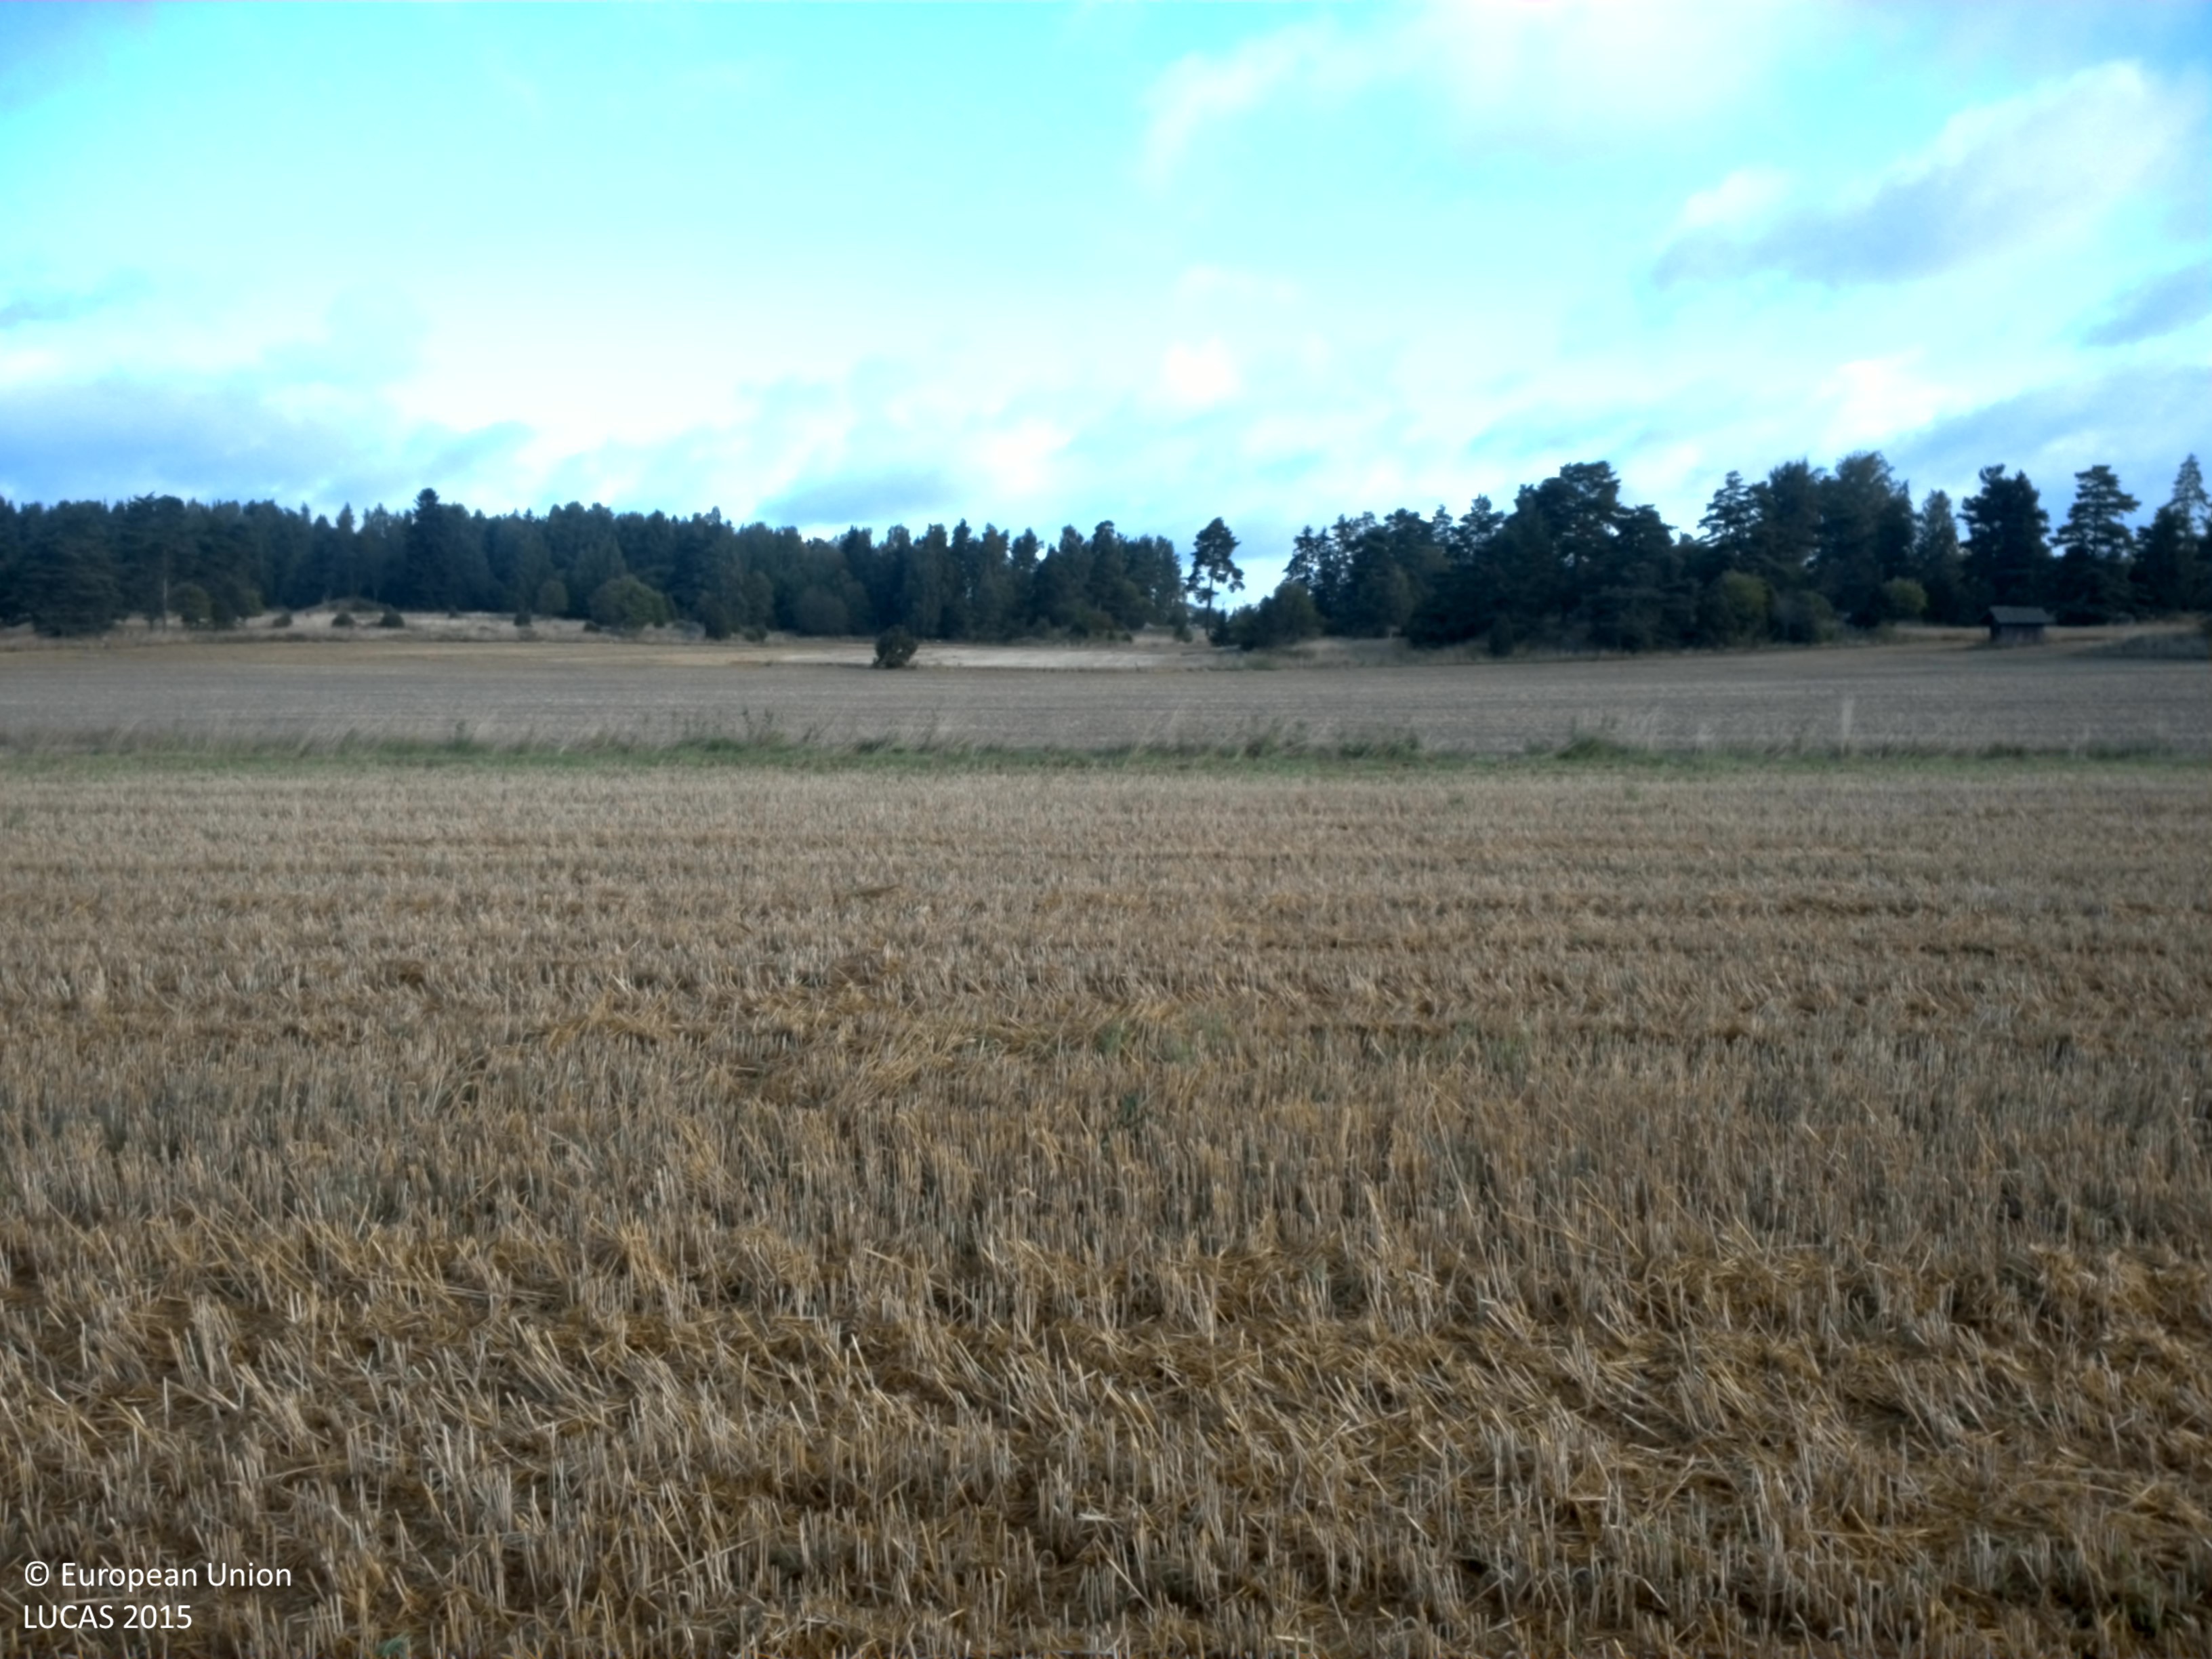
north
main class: Cropland
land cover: Common wheat
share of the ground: < 10 %
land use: Agriculture (excluding fallow land and kitchen gardens)
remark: Harvested field
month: August
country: SE
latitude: 59.7848
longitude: 17.1009
